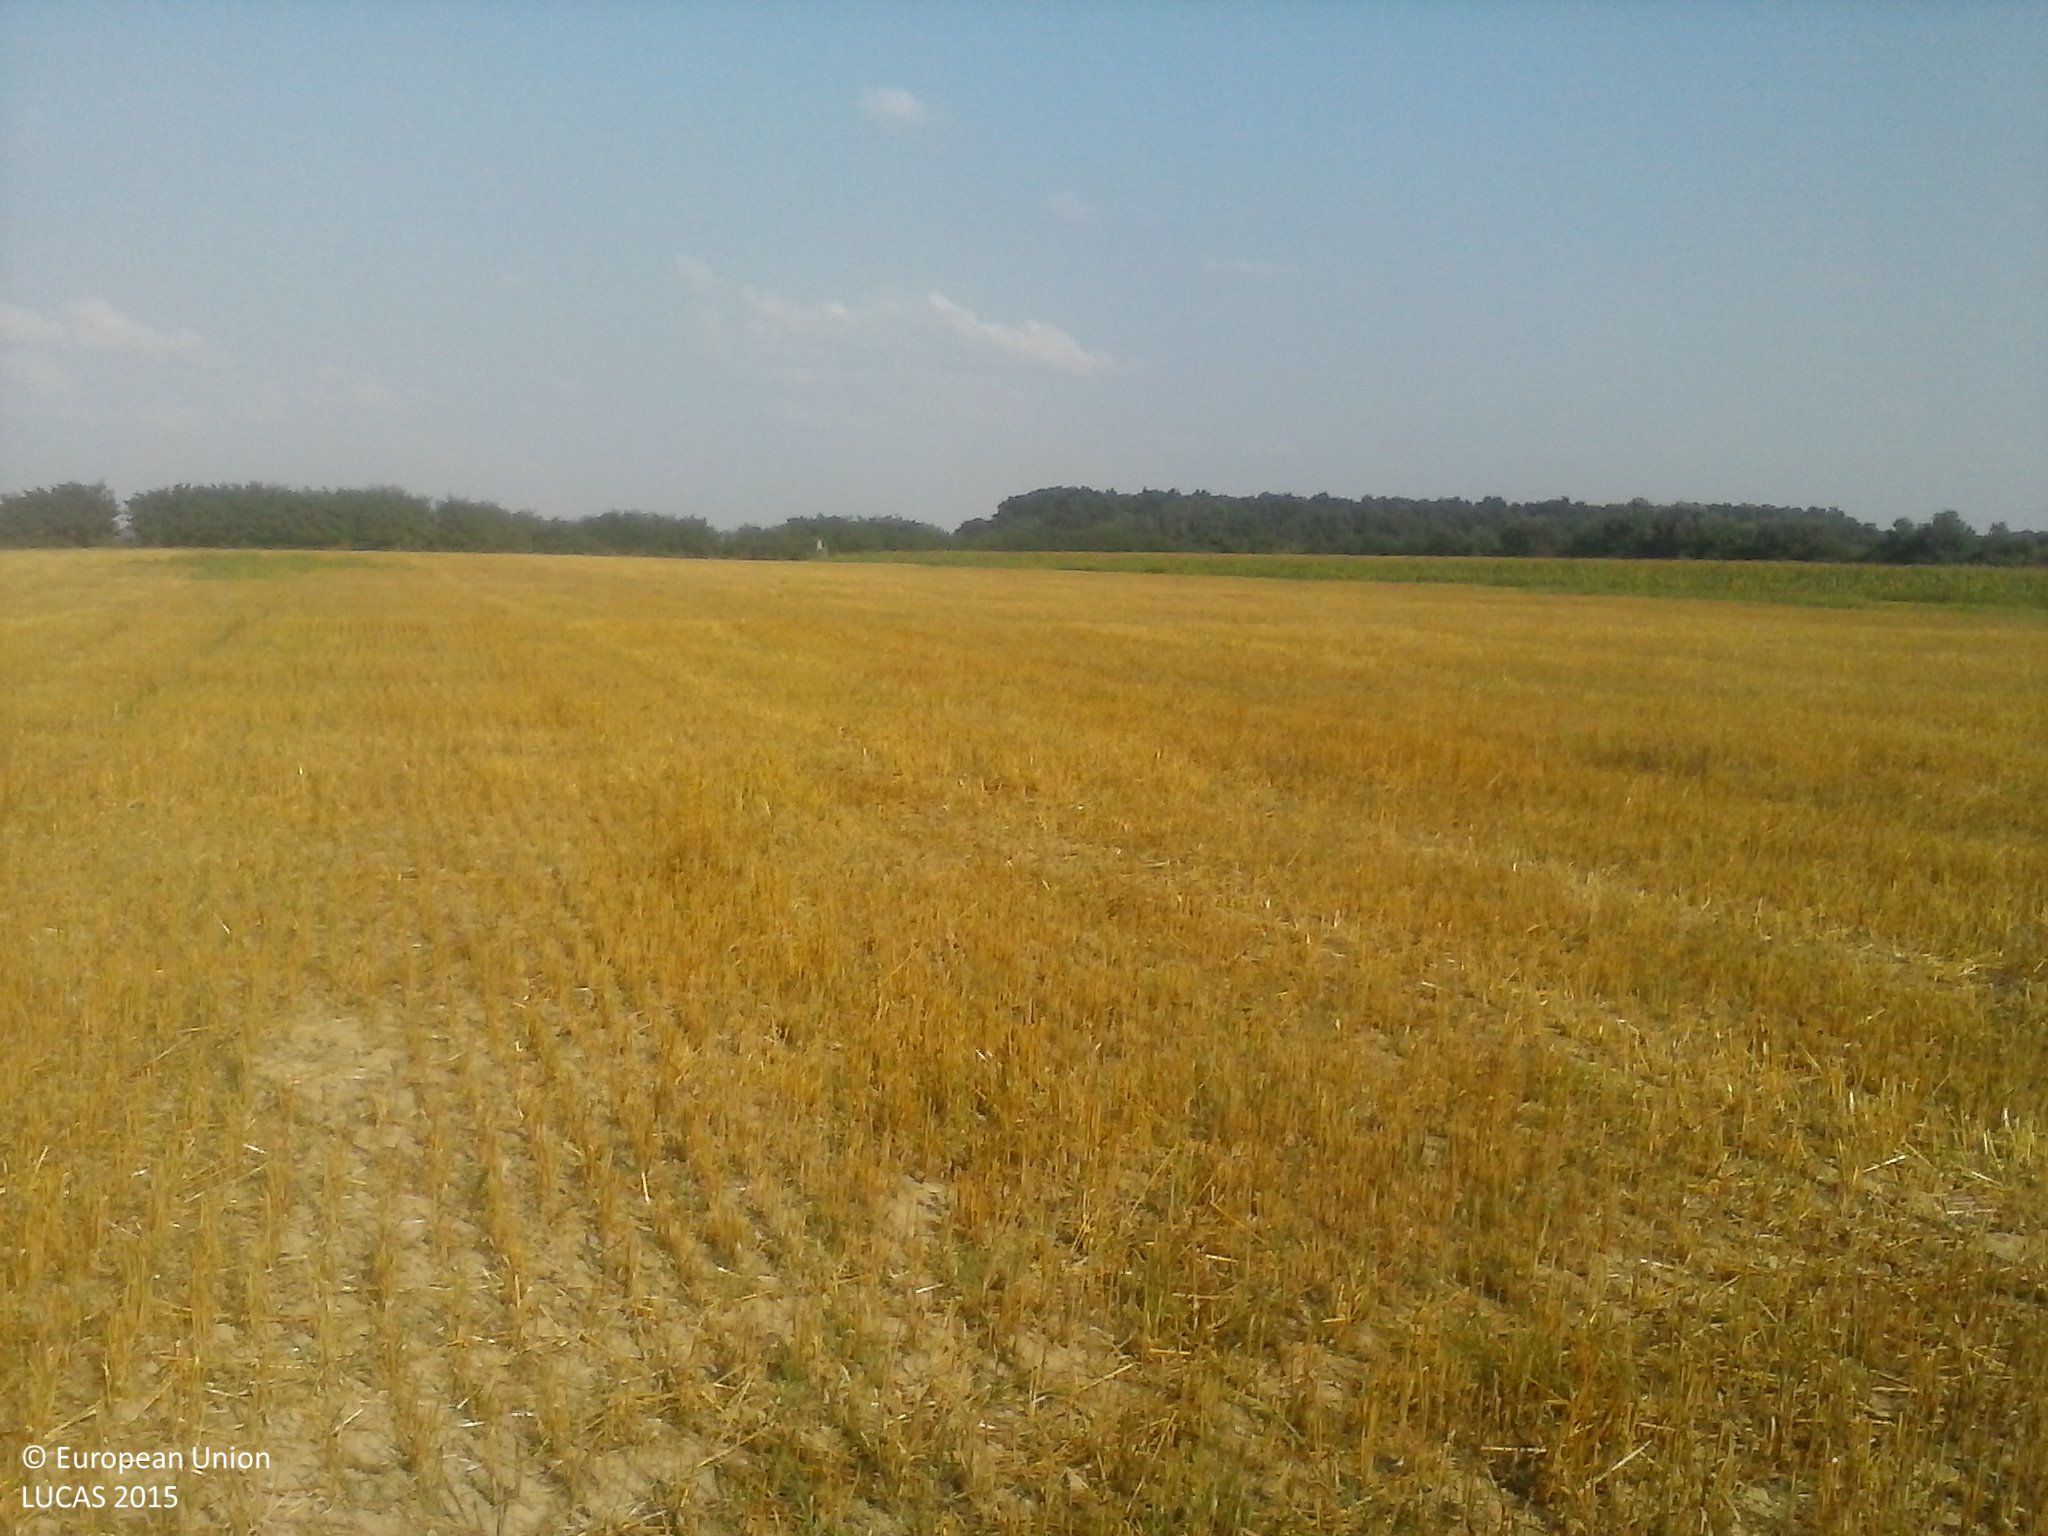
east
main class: Cropland
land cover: Oats
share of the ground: > 75 %
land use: Agriculture (excluding fallow land and kitchen gardens)
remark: Harvested field
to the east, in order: Oats
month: August
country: HU
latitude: 46.0124
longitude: 17.7926
